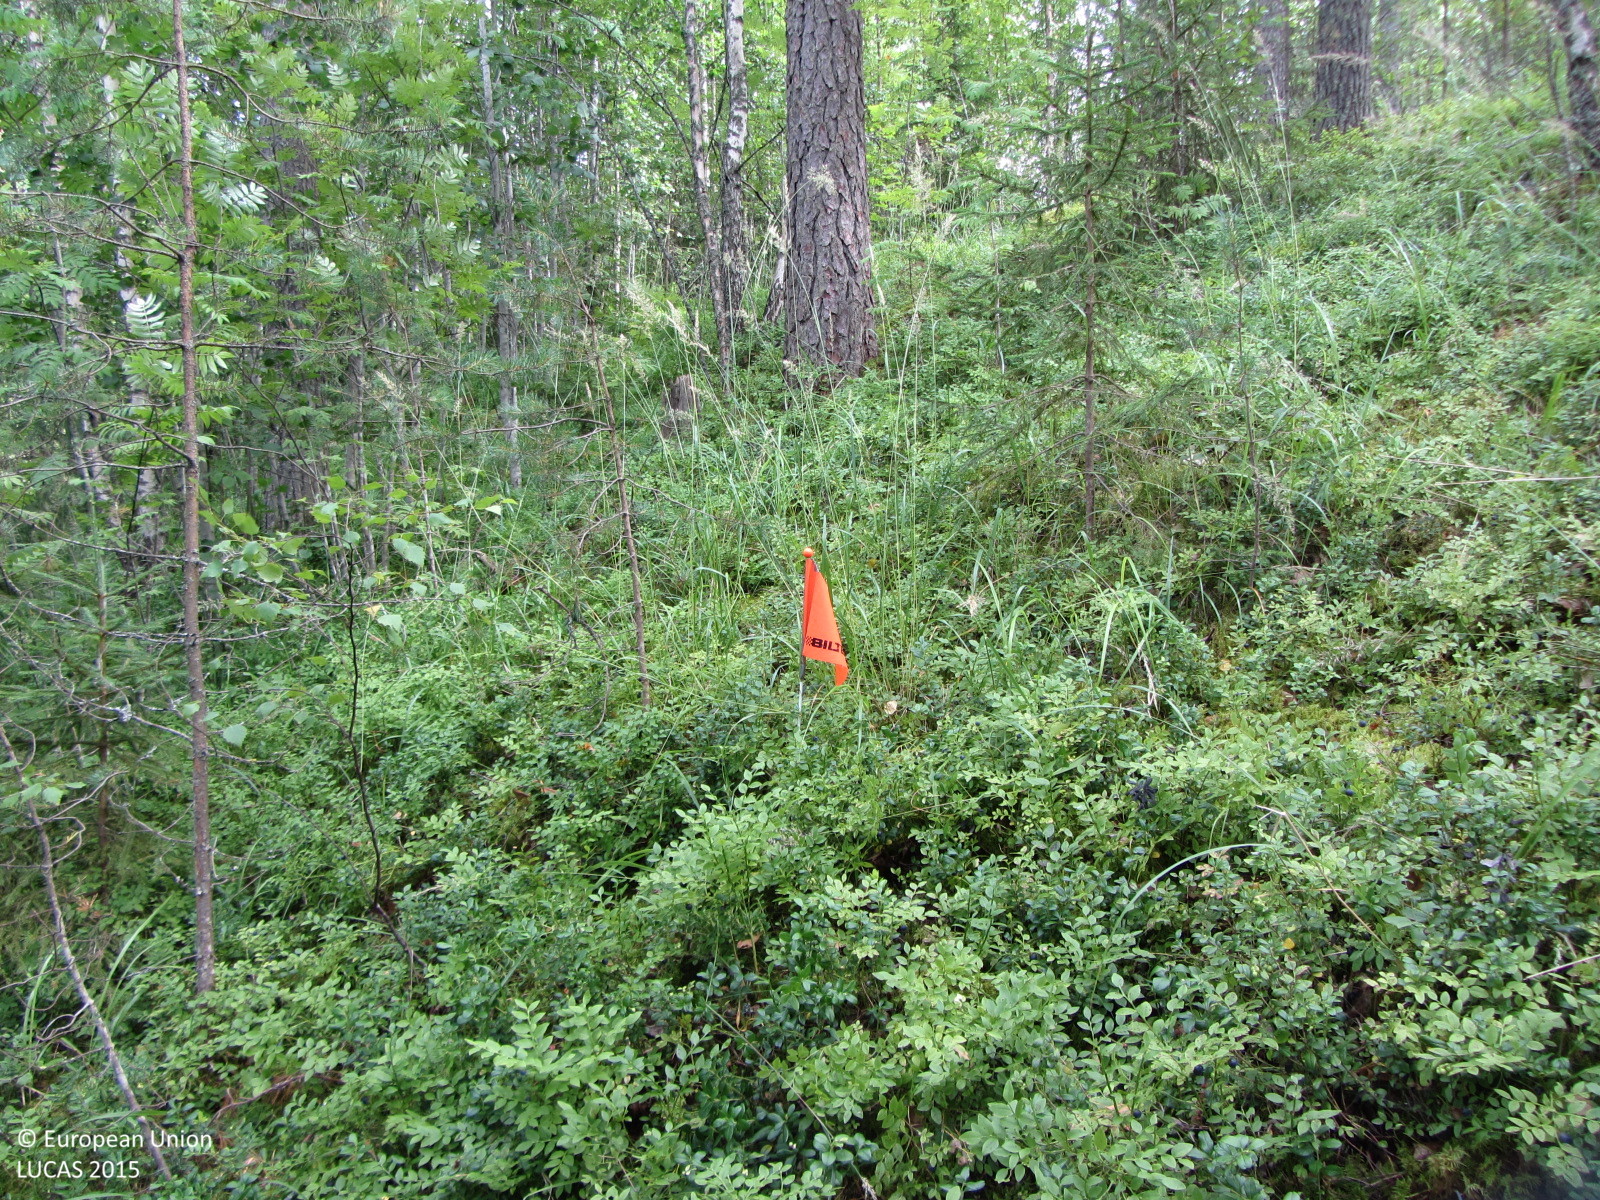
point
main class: Woodland
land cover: Pine dominated mixed woodland
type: boreal forest
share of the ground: 50 - 75 %
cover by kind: broadleaved forest trees 35 %, shrubs 35 %, coniferous forest trees 25 %, herbaceous plants 5 %
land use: Forestry
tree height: > 5 m
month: August
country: FI
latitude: 60.6581
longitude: 24.6527
